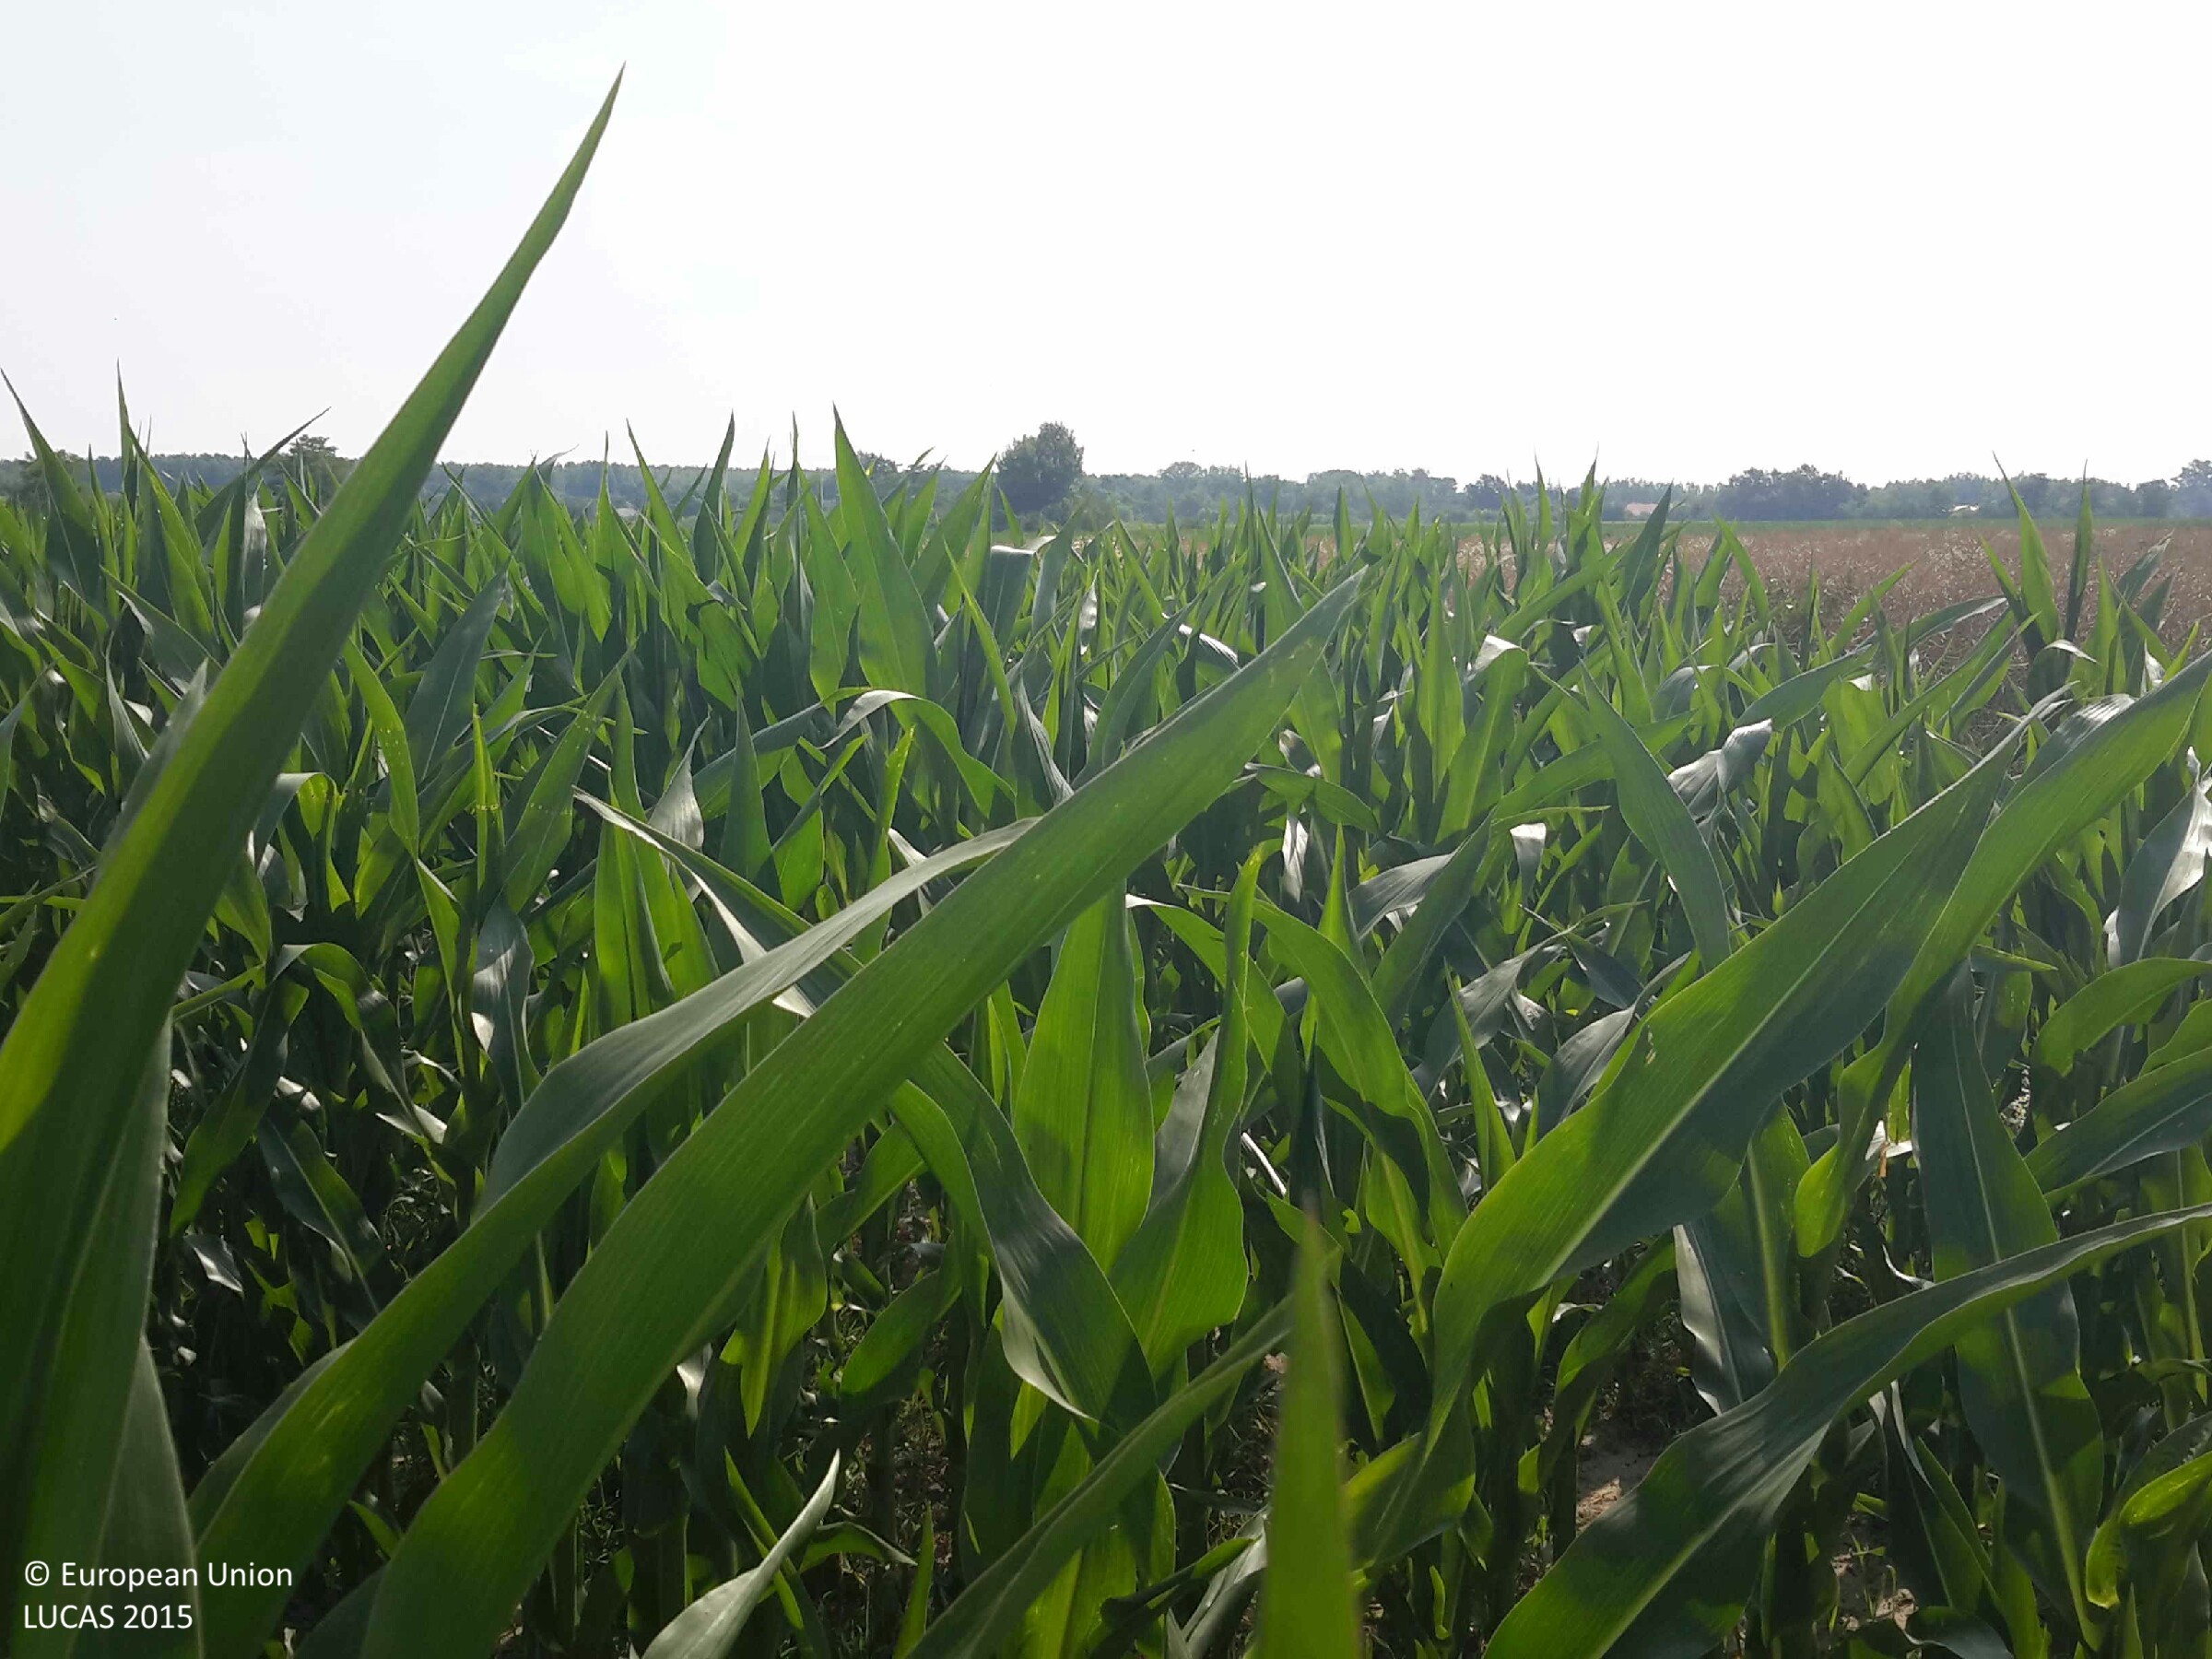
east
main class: Cropland
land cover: Maize
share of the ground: > 75 %
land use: Agriculture (excluding fallow land and kitchen gardens)
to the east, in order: Maize; Rape and turnip rape; Maize
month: July
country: HU
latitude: 47.3955
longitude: 17.4135
